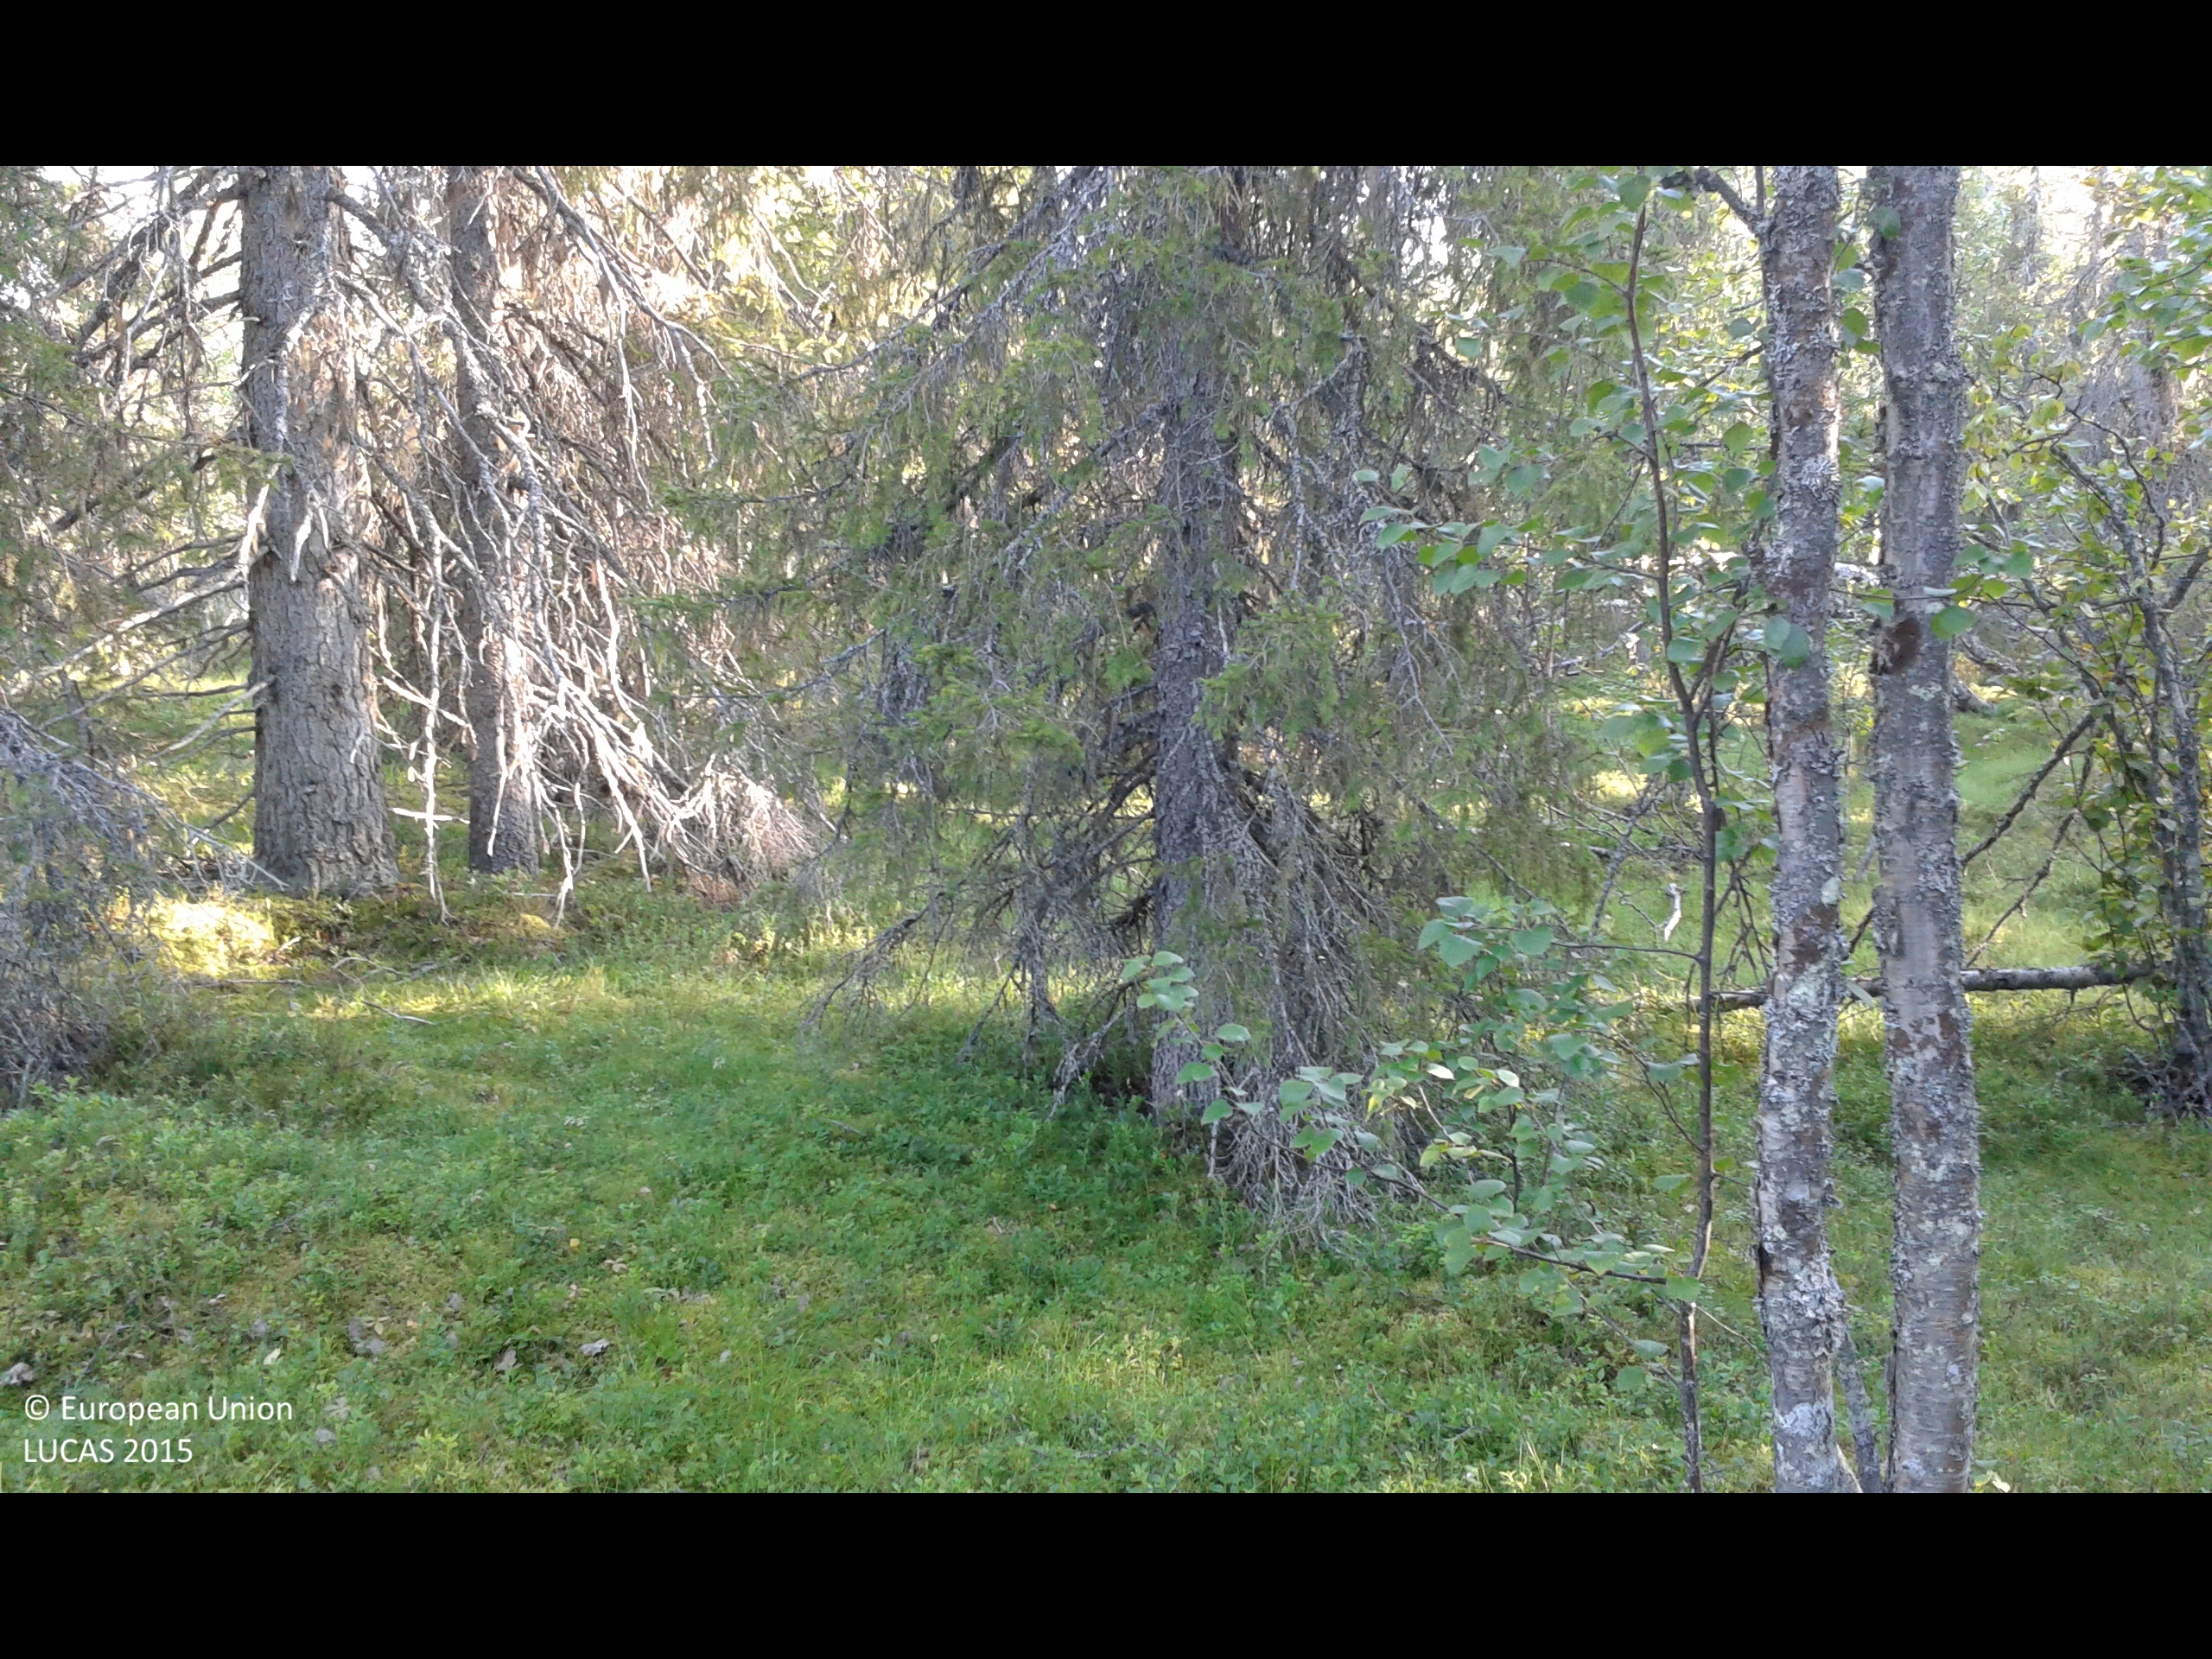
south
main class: Woodland
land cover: Spruce dominated mixed woodland
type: boreal forest
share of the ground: 25 - 50 %
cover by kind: shrubs 50 %, coniferous forest trees 25 %, lichens and mosses 15 %, broadleaved forest trees 10 %
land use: Forestry
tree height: > 5 m
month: August
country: SE
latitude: 67.3158
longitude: 21.1731
